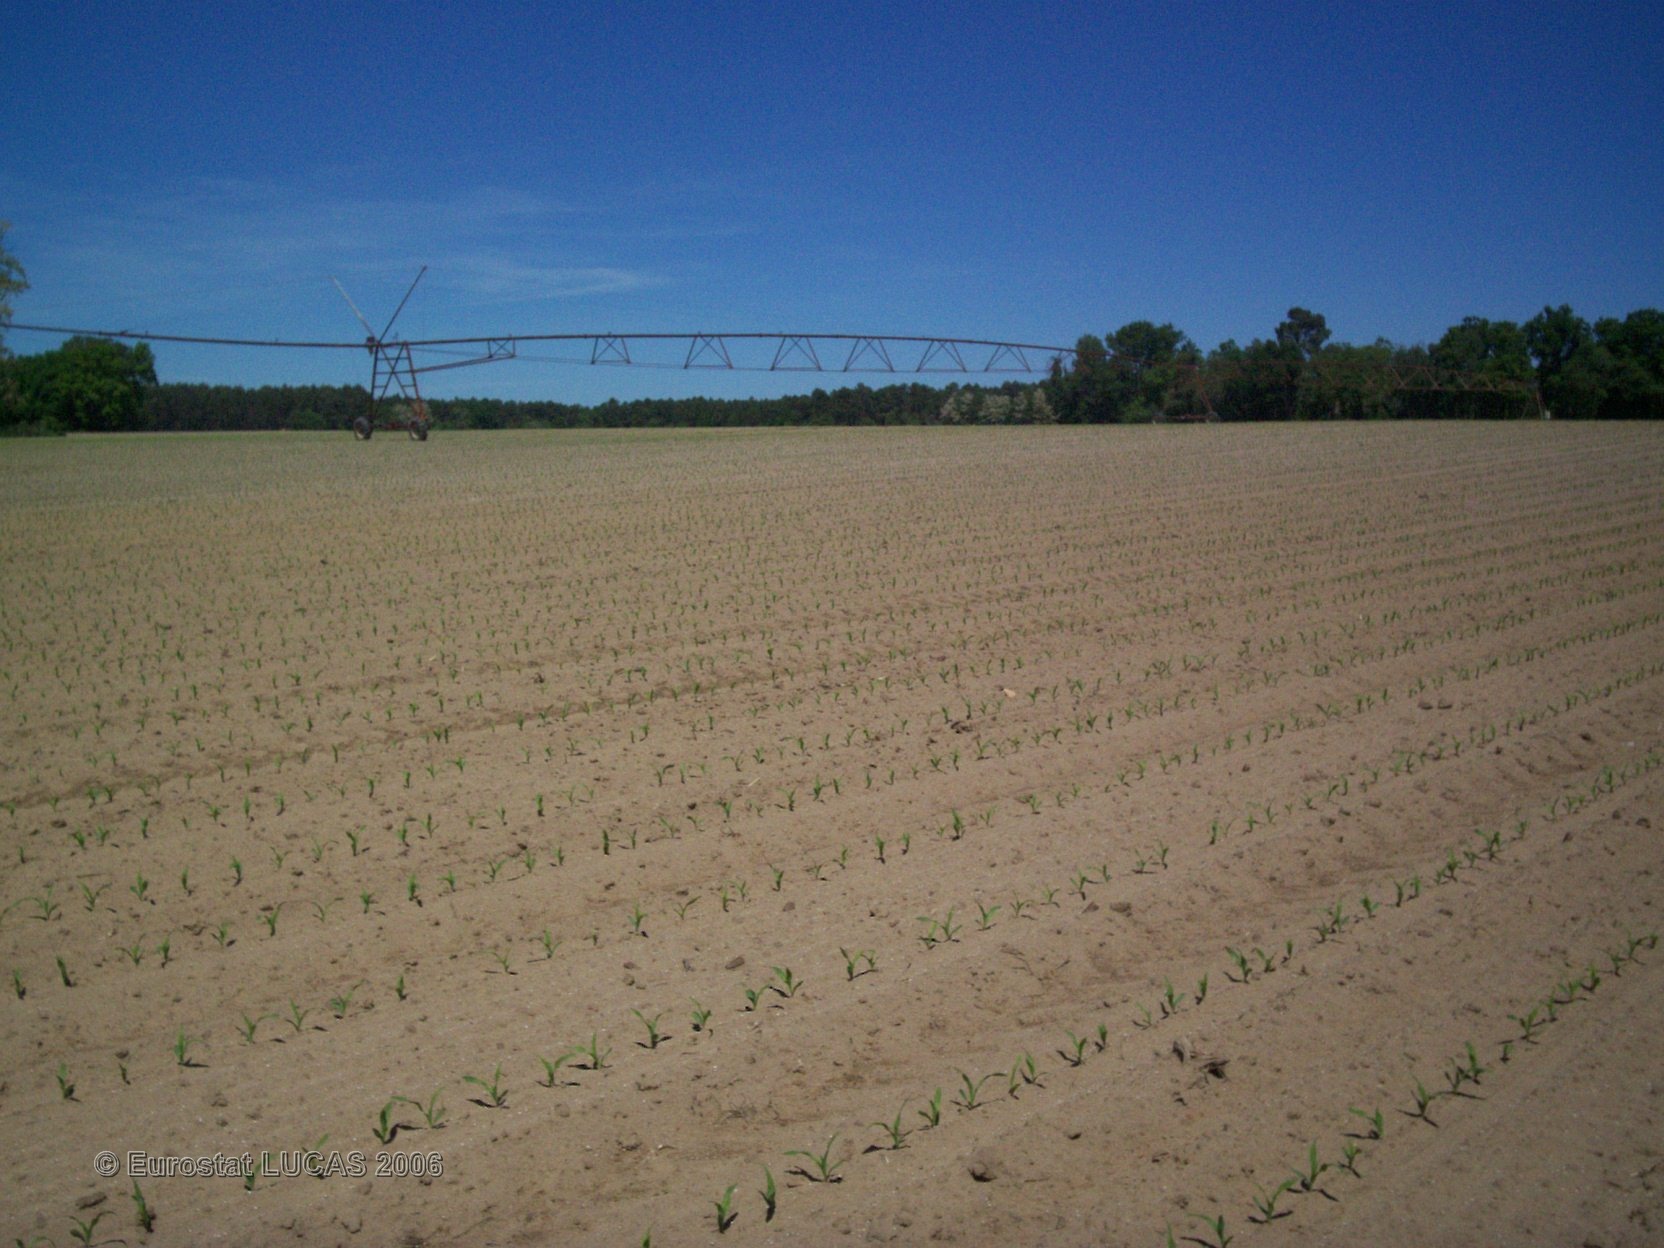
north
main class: Cropland
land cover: Maize
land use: Agriculture (excluding fallow land and kitchen gardens)
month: May
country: FR
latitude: 43.9905
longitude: -0.7505
